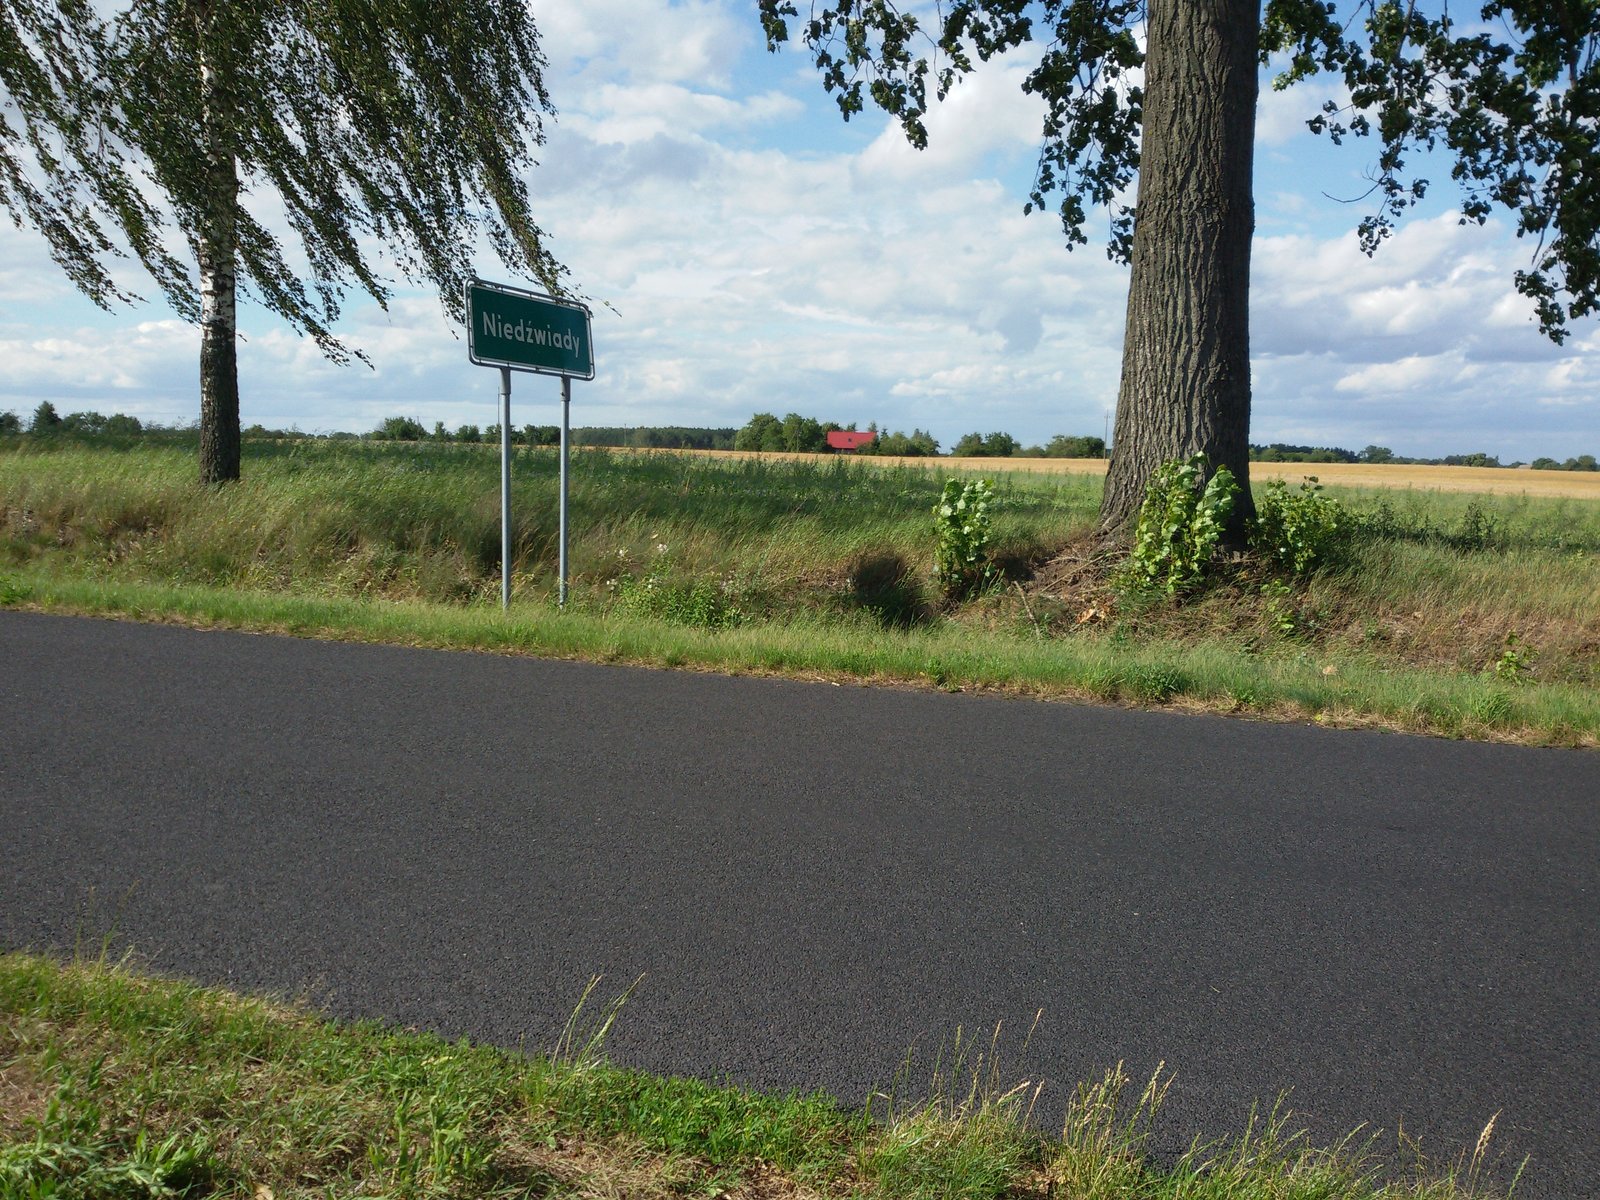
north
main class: Cropland
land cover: Triticale
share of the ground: > 75 %
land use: Agriculture (excluding fallow land and kitchen gardens)
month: July
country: PL
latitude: 52.7290
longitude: 17.6094
